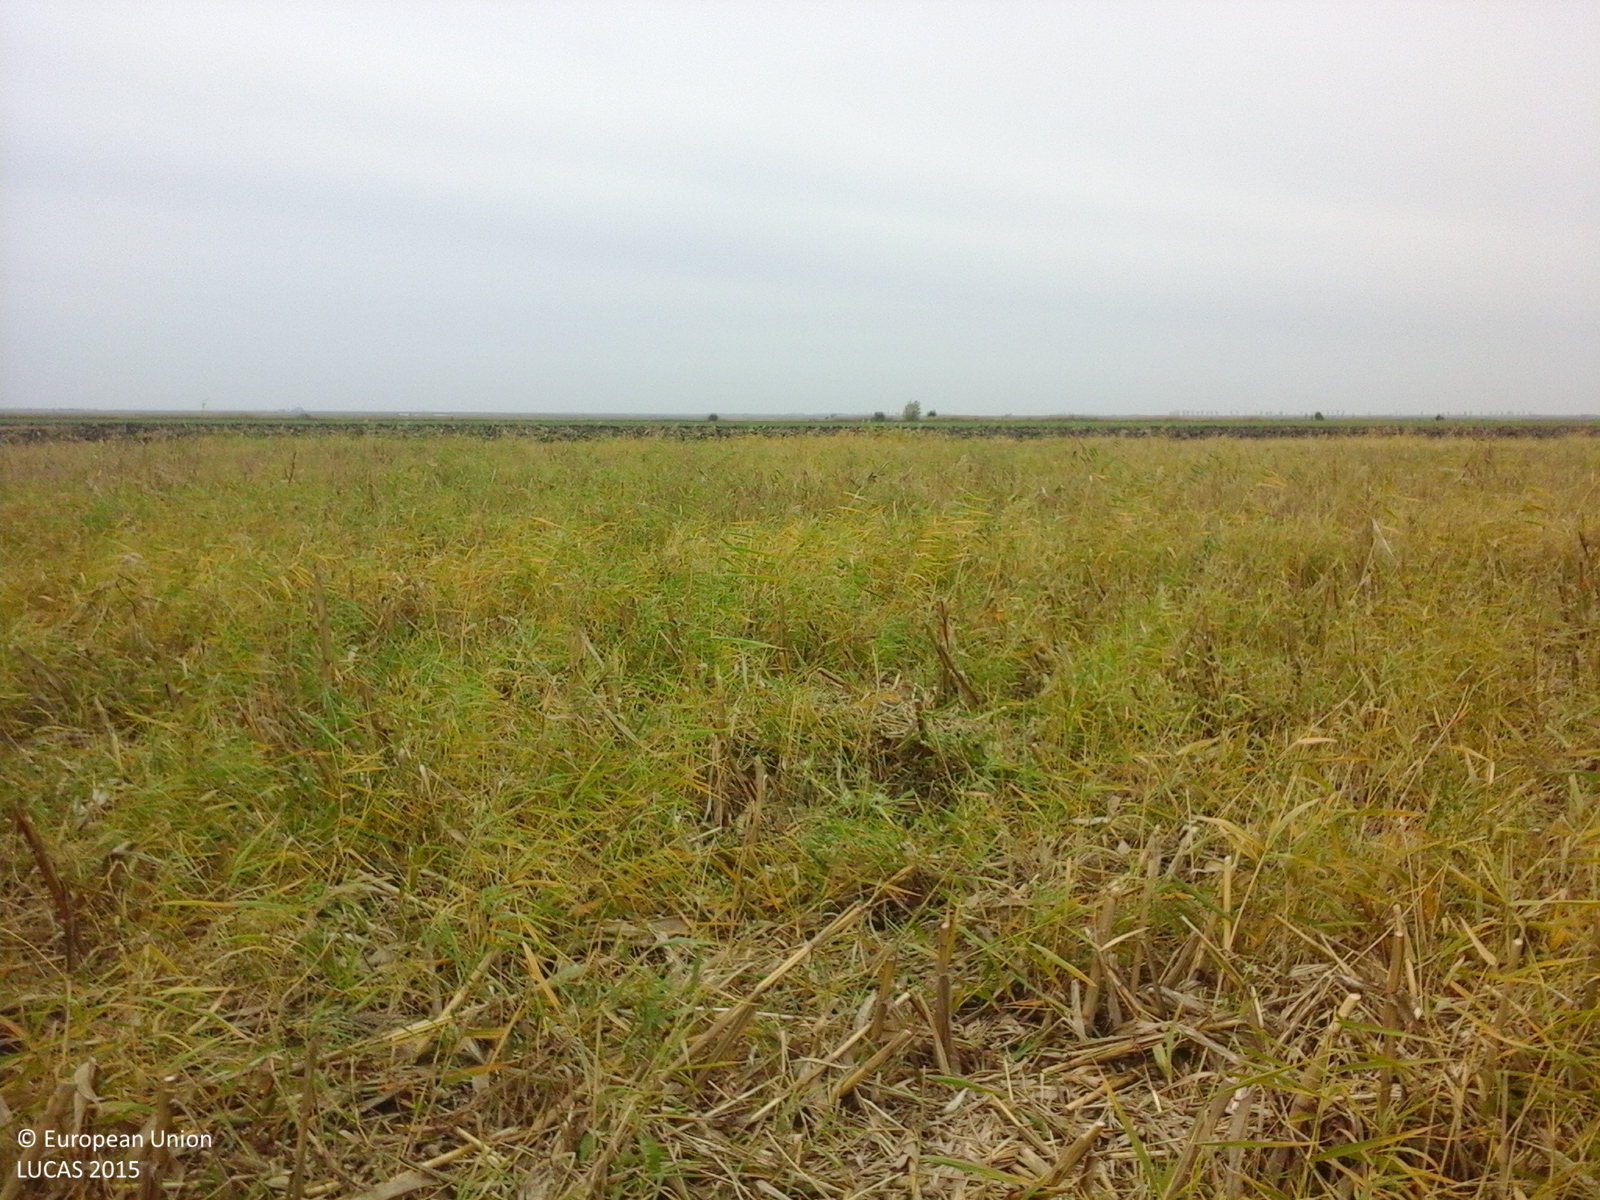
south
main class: Cropland
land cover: Maize
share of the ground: 50 - 75 %
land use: Agriculture (excluding fallow land and kitchen gardens)
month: October
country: RO
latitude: 44.9277
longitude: 26.3983
